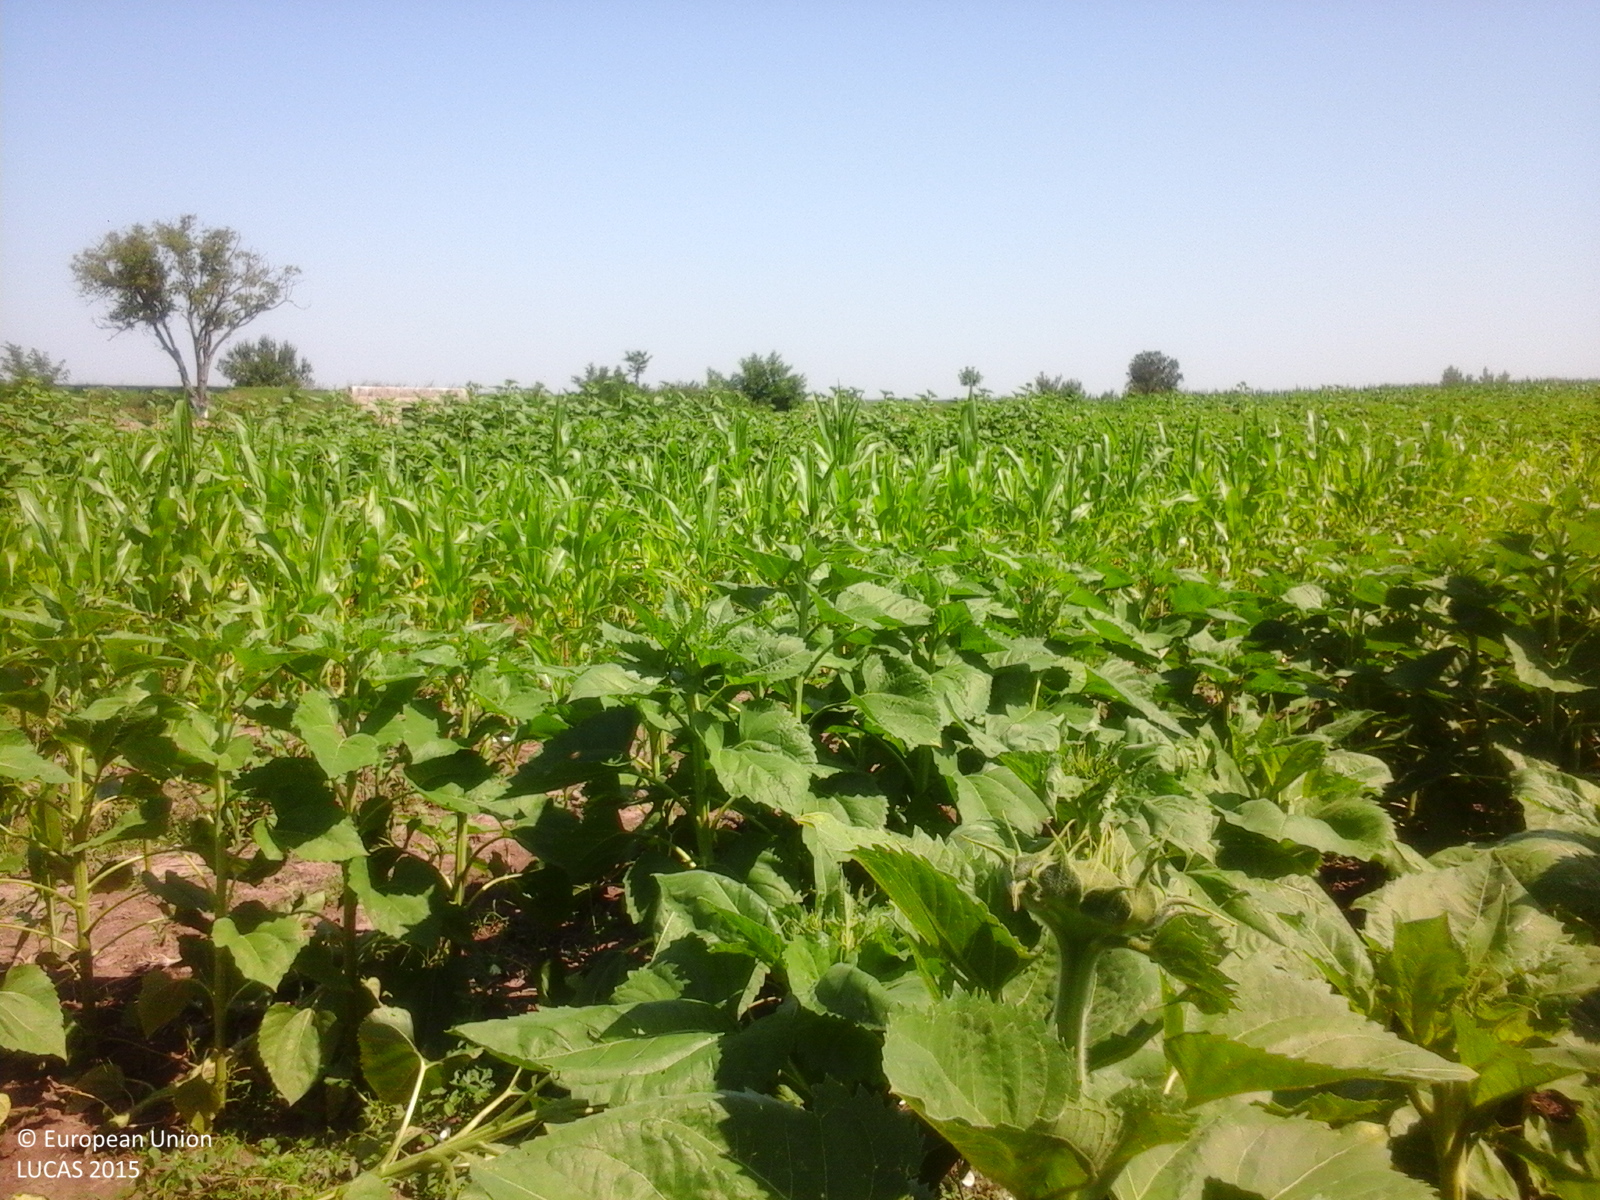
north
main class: Cropland
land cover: Sunflower
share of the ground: > 75 %
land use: Agriculture (excluding fallow land and kitchen gardens)
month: July
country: RO
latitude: 44.5293
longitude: 24.5301
